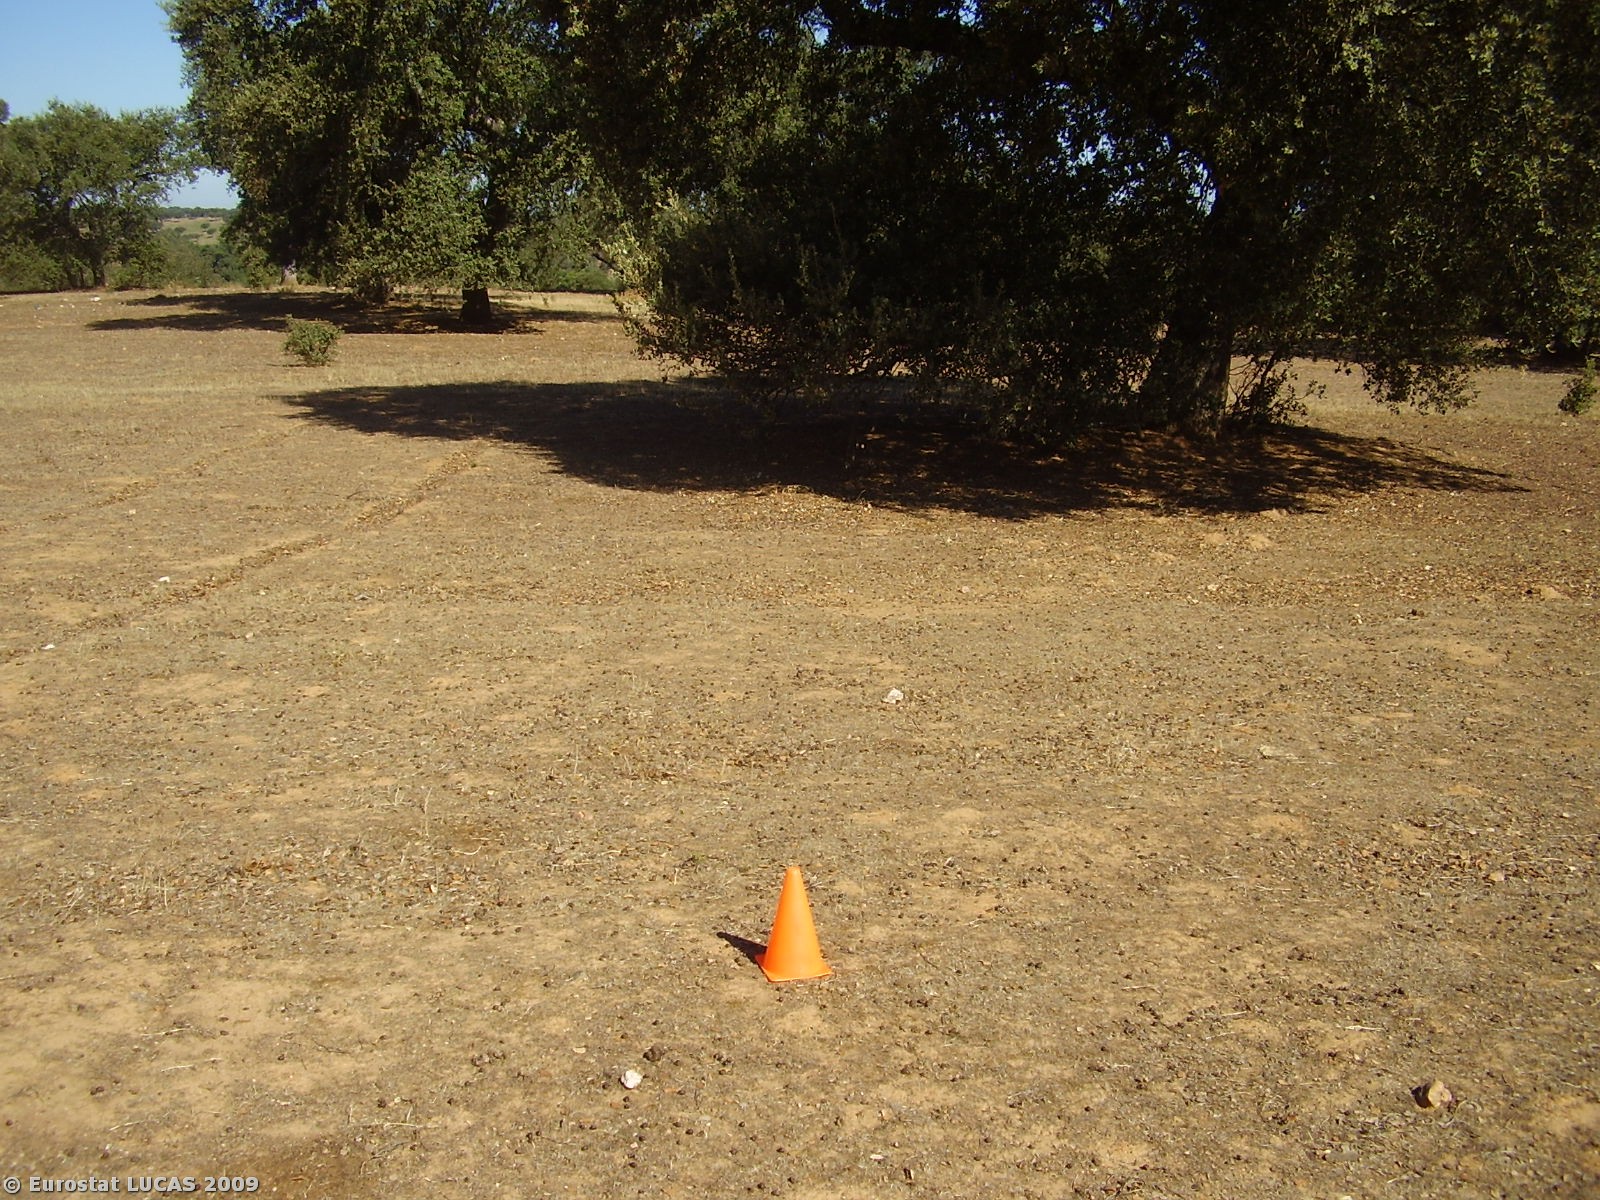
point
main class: Woodland
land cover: Broadleaved woodland
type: broadleaved evergreen forest
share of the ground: 10 - 25 %
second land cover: Bare land
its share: 50 - 75 %
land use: Forestry
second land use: Fallow land
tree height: > 5 m
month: July
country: PT
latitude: 38.8779
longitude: -7.8294
